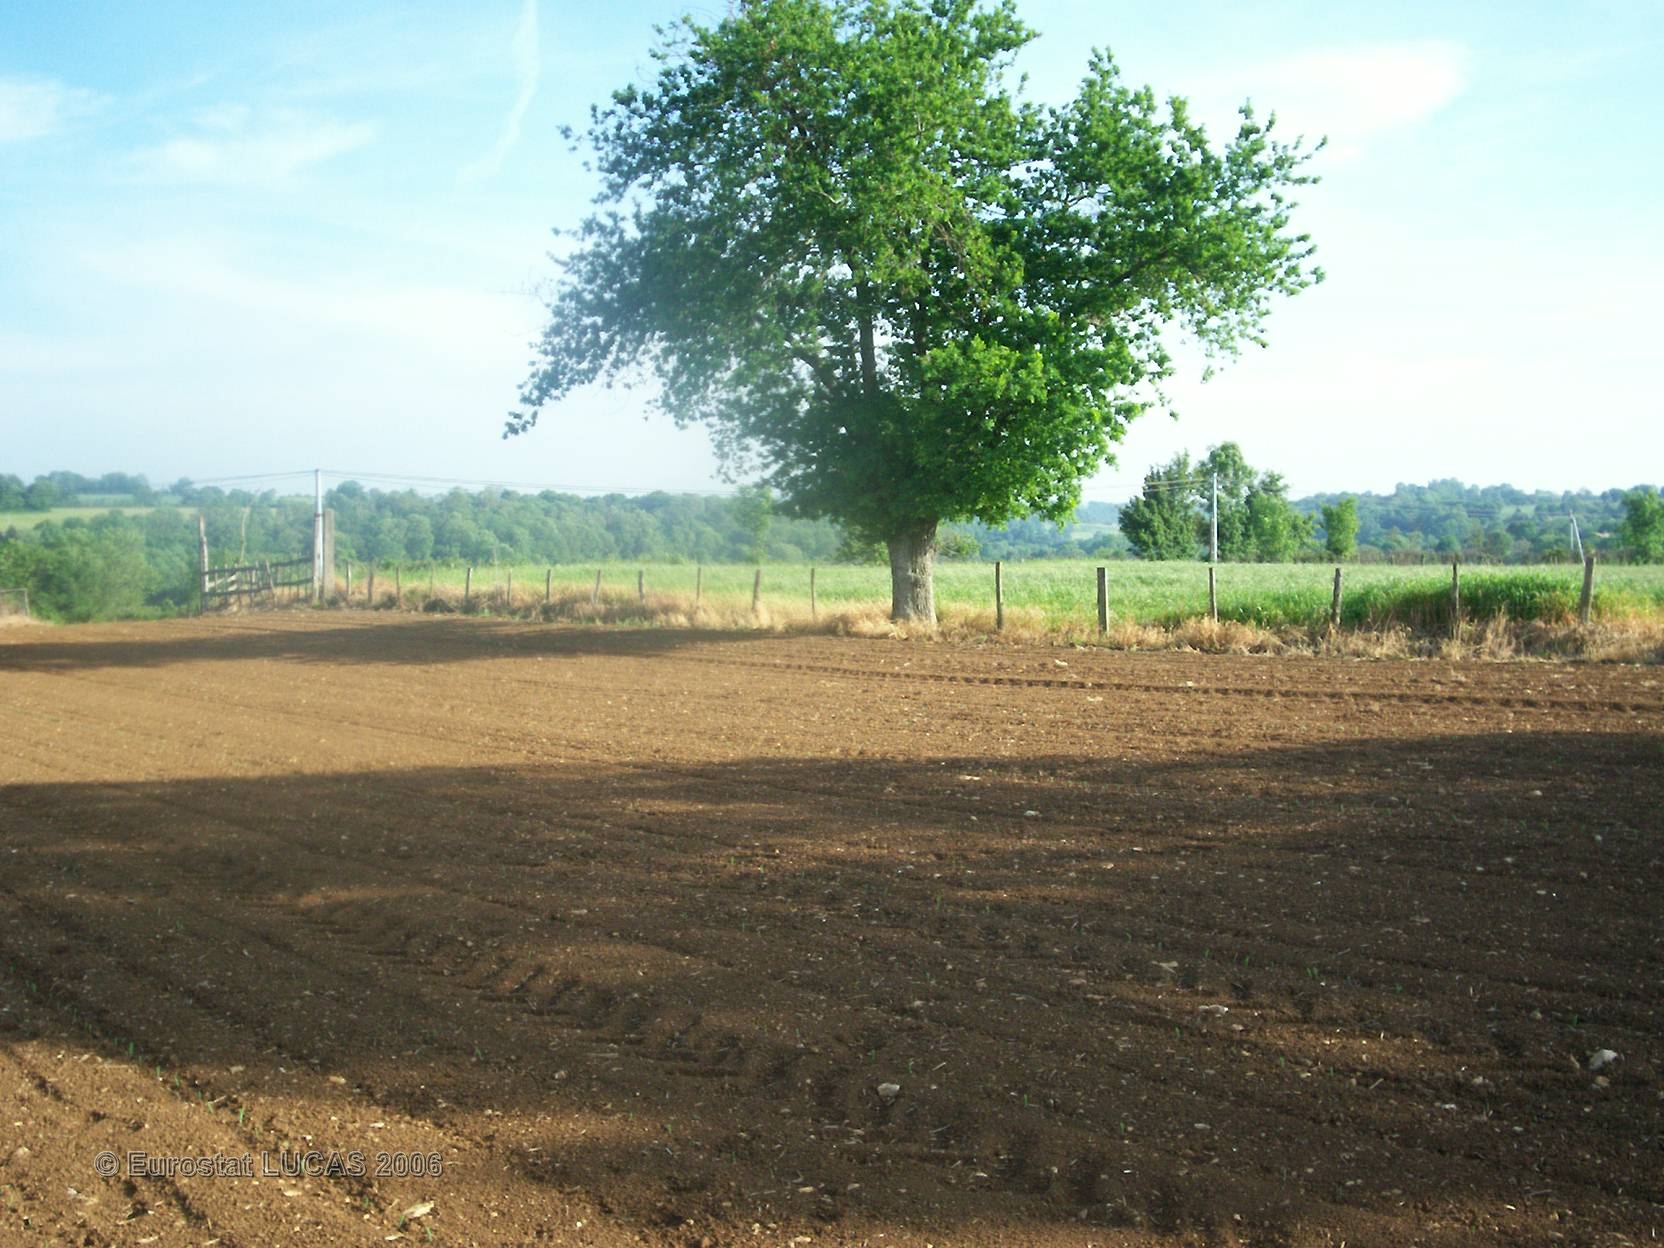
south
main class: Cropland
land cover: Maize
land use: Agriculture (excluding fallow land and kitchen gardens)
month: May
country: FR
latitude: 46.4342
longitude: -0.2927
